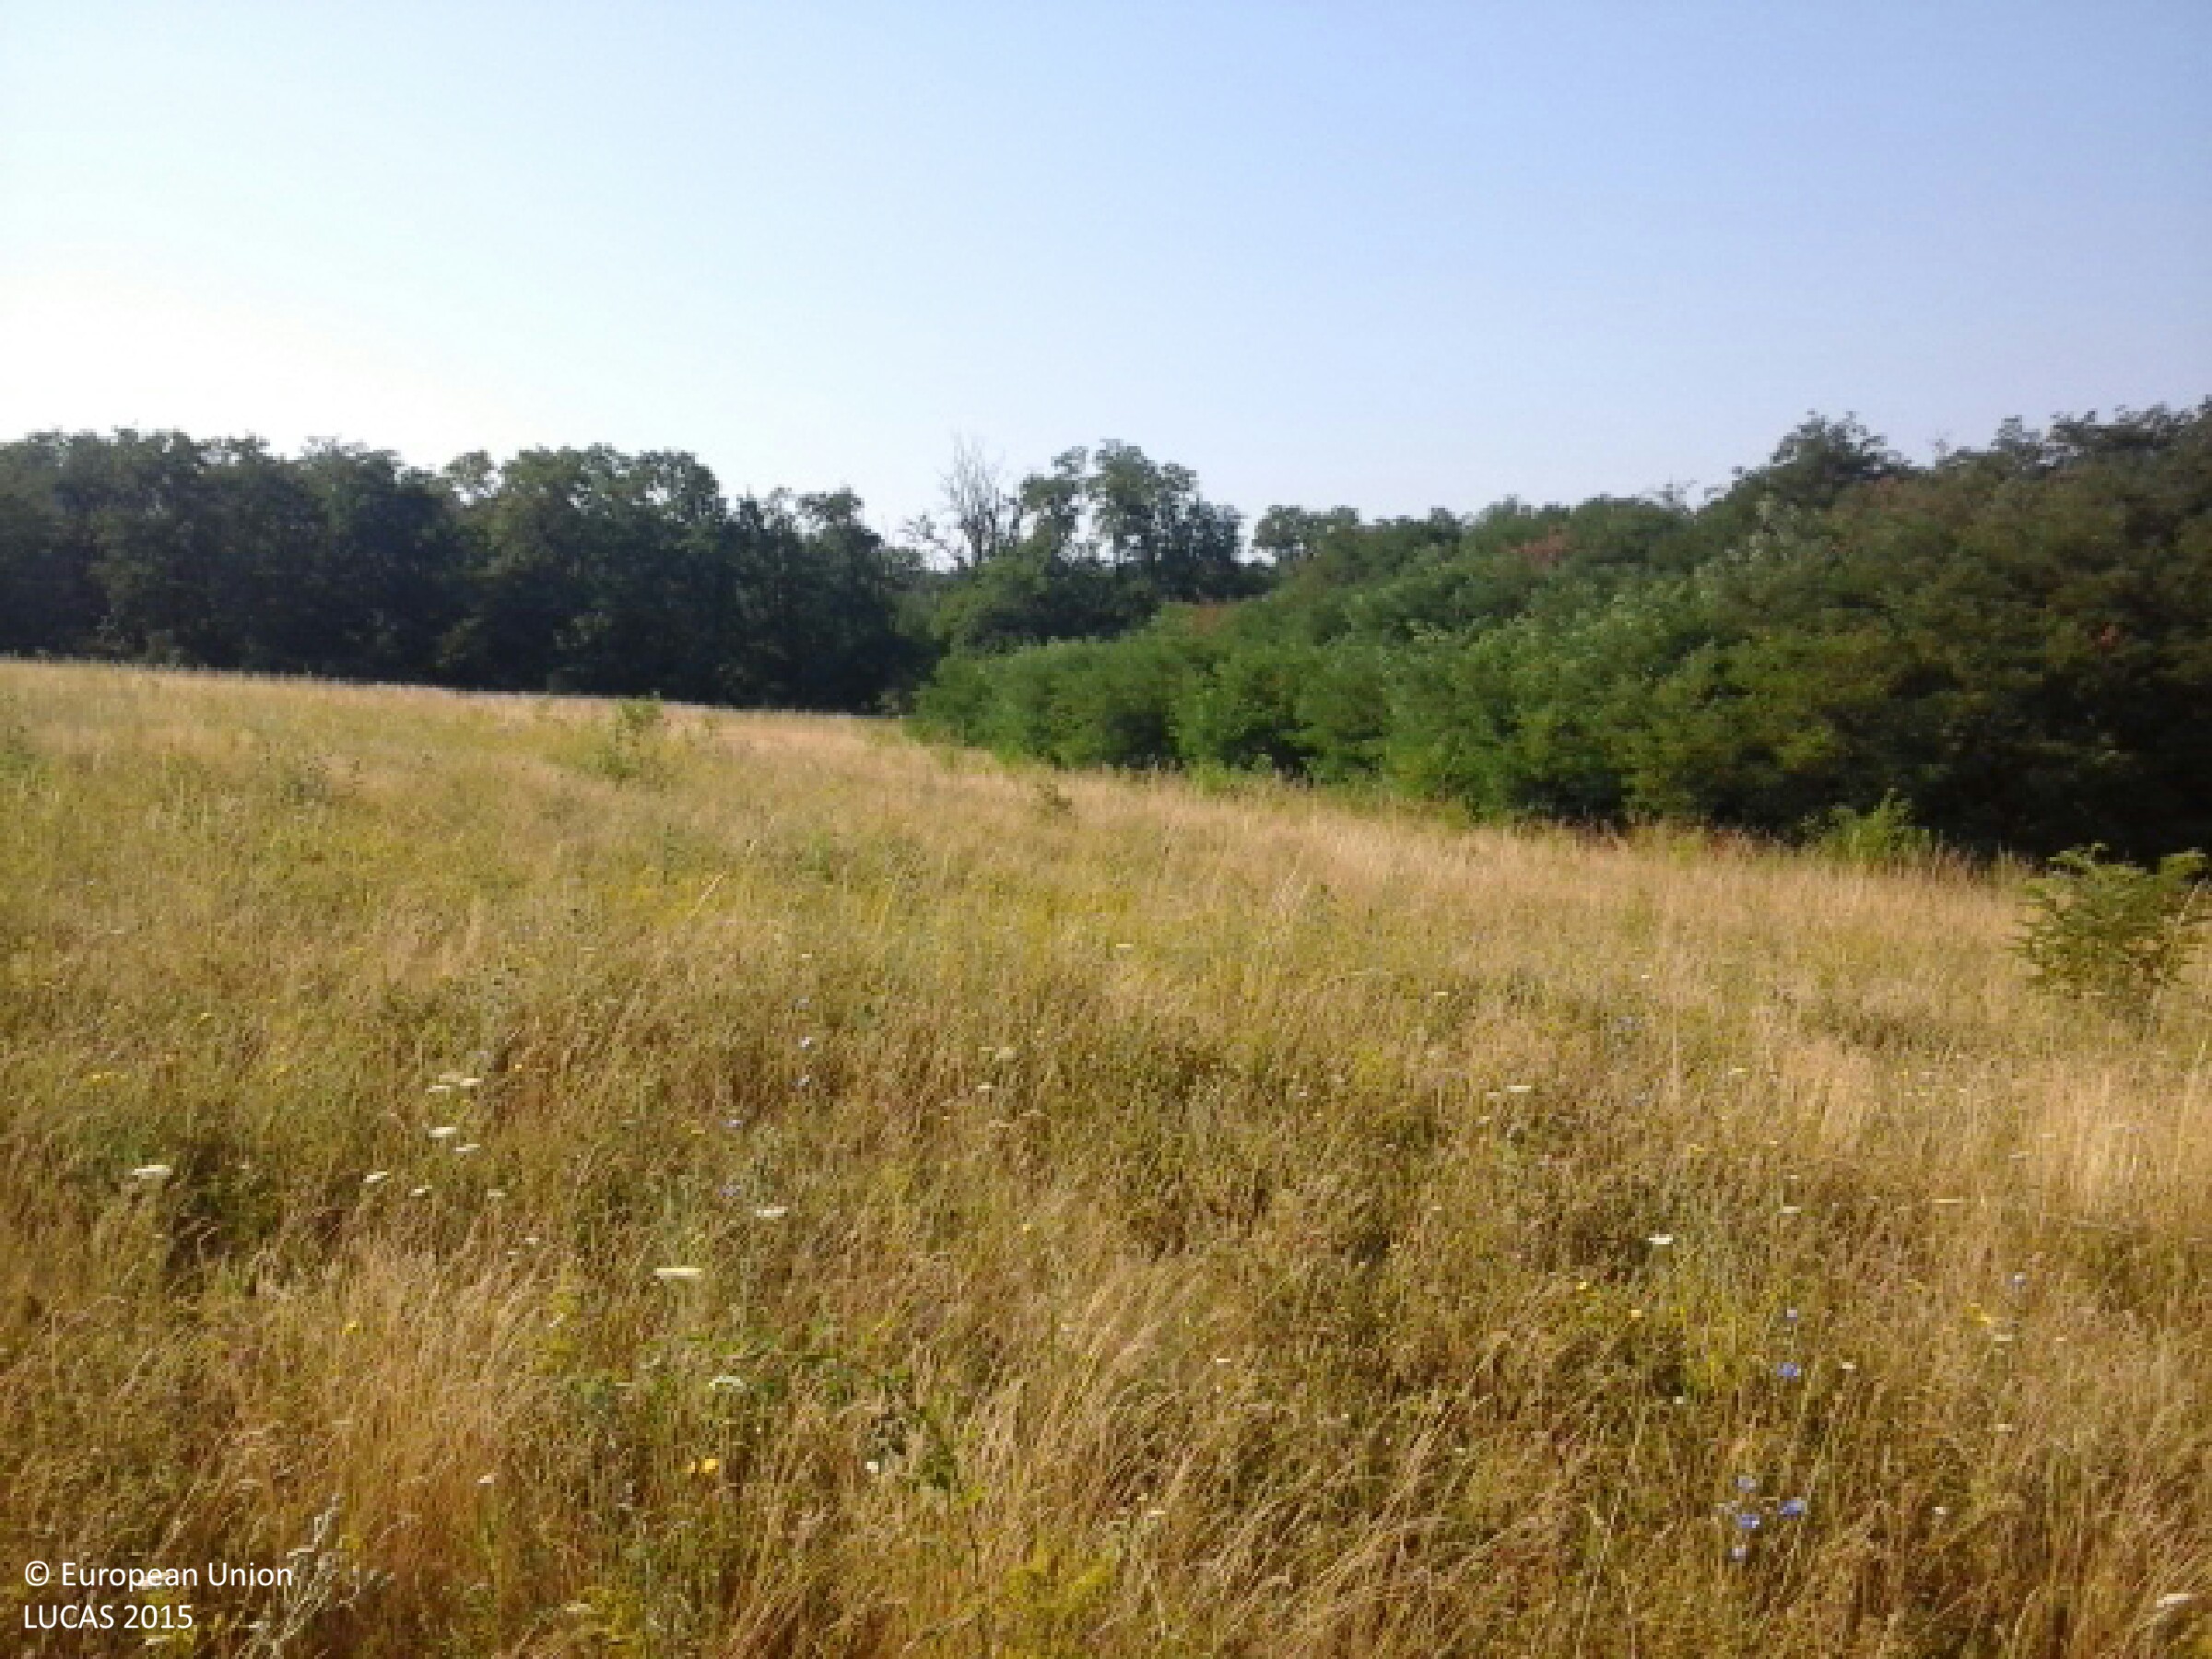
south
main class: Grassland
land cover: Spontaneously vegetated surfaces
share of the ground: > 75 %
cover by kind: herbaceous plants 100 %
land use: Fallow land
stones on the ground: < 10 %
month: July
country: HU
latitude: 48.4186
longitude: 20.9713
